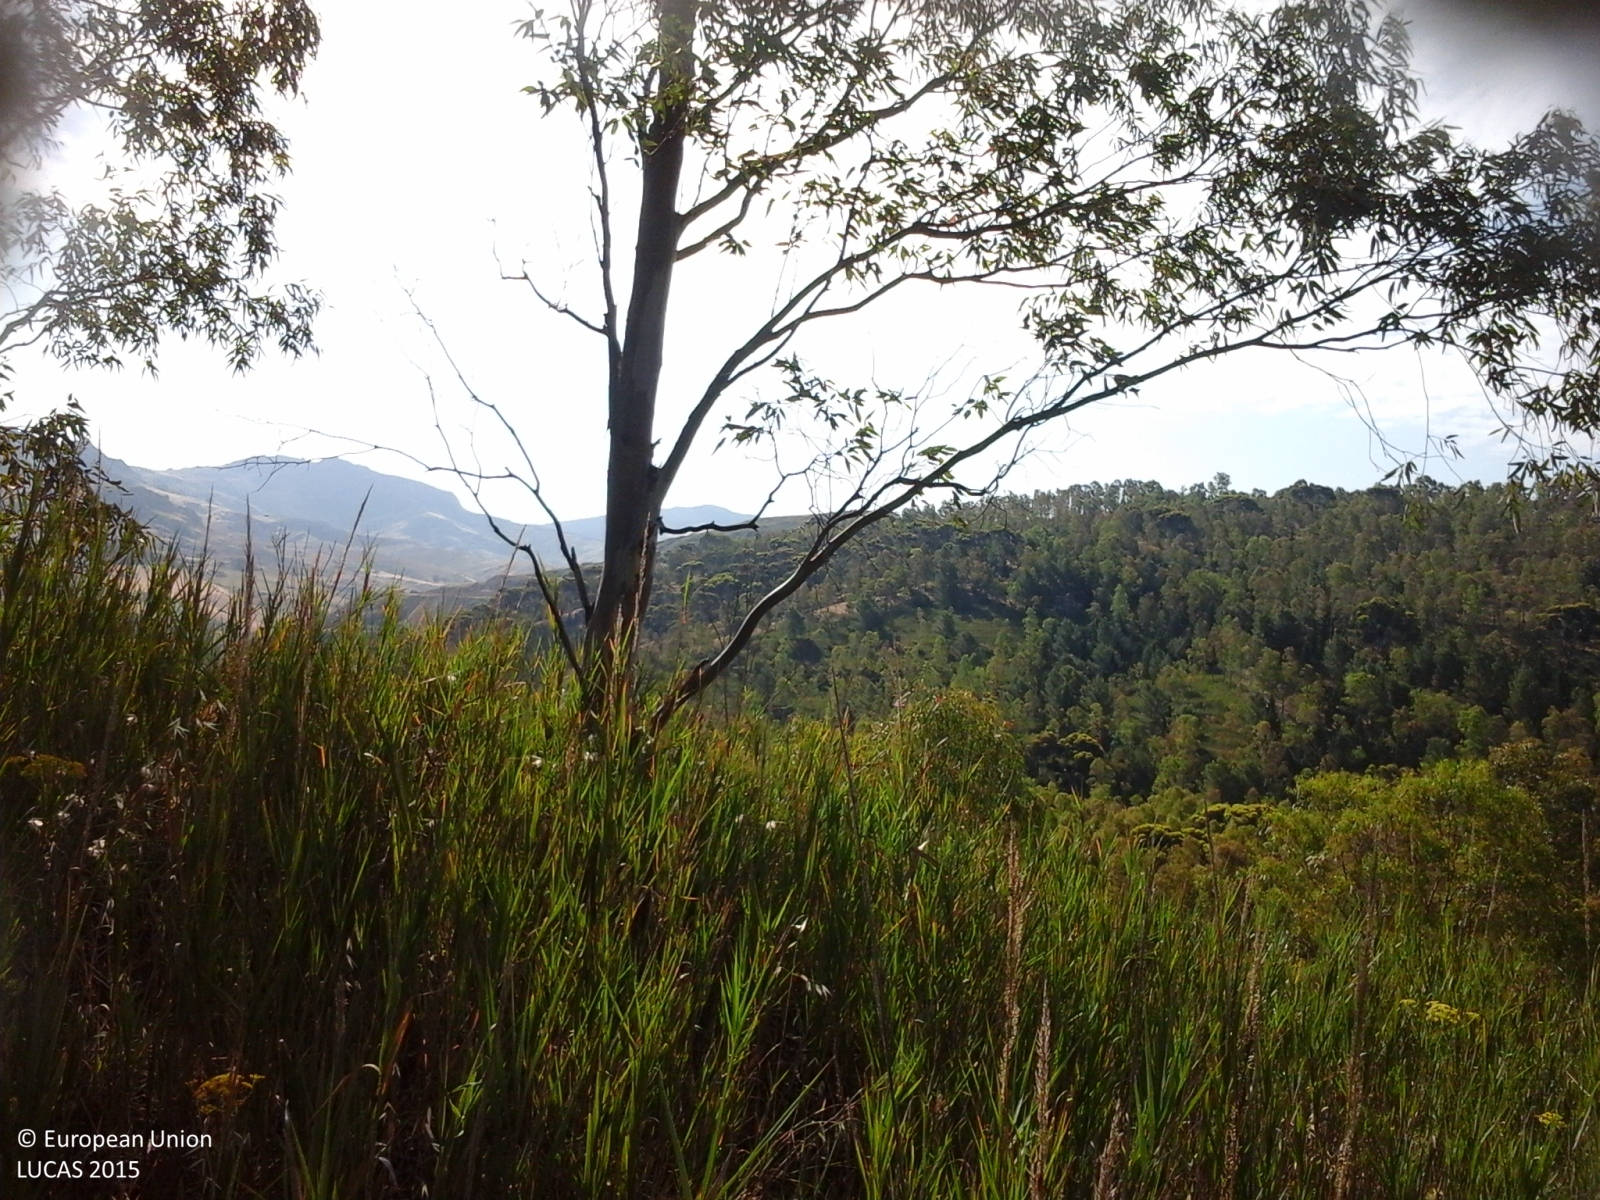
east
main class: Woodland
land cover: Broadleaved woodland
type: broadleaved evergreen forest
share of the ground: > 75 %
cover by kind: broadleaved forest trees 90 %, shrubs 5 %, herbaceous plants 5 %
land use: Forestry
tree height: > 5 m
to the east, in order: Broadleaved woodland; Grassland without tree/shrub cover; Shrubland without tree cover; Inland fresh running water; Shrubland without tree cover; Other bare soil; Broadleaved woodland
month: June
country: IT
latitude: 37.4587
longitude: 13.6689
